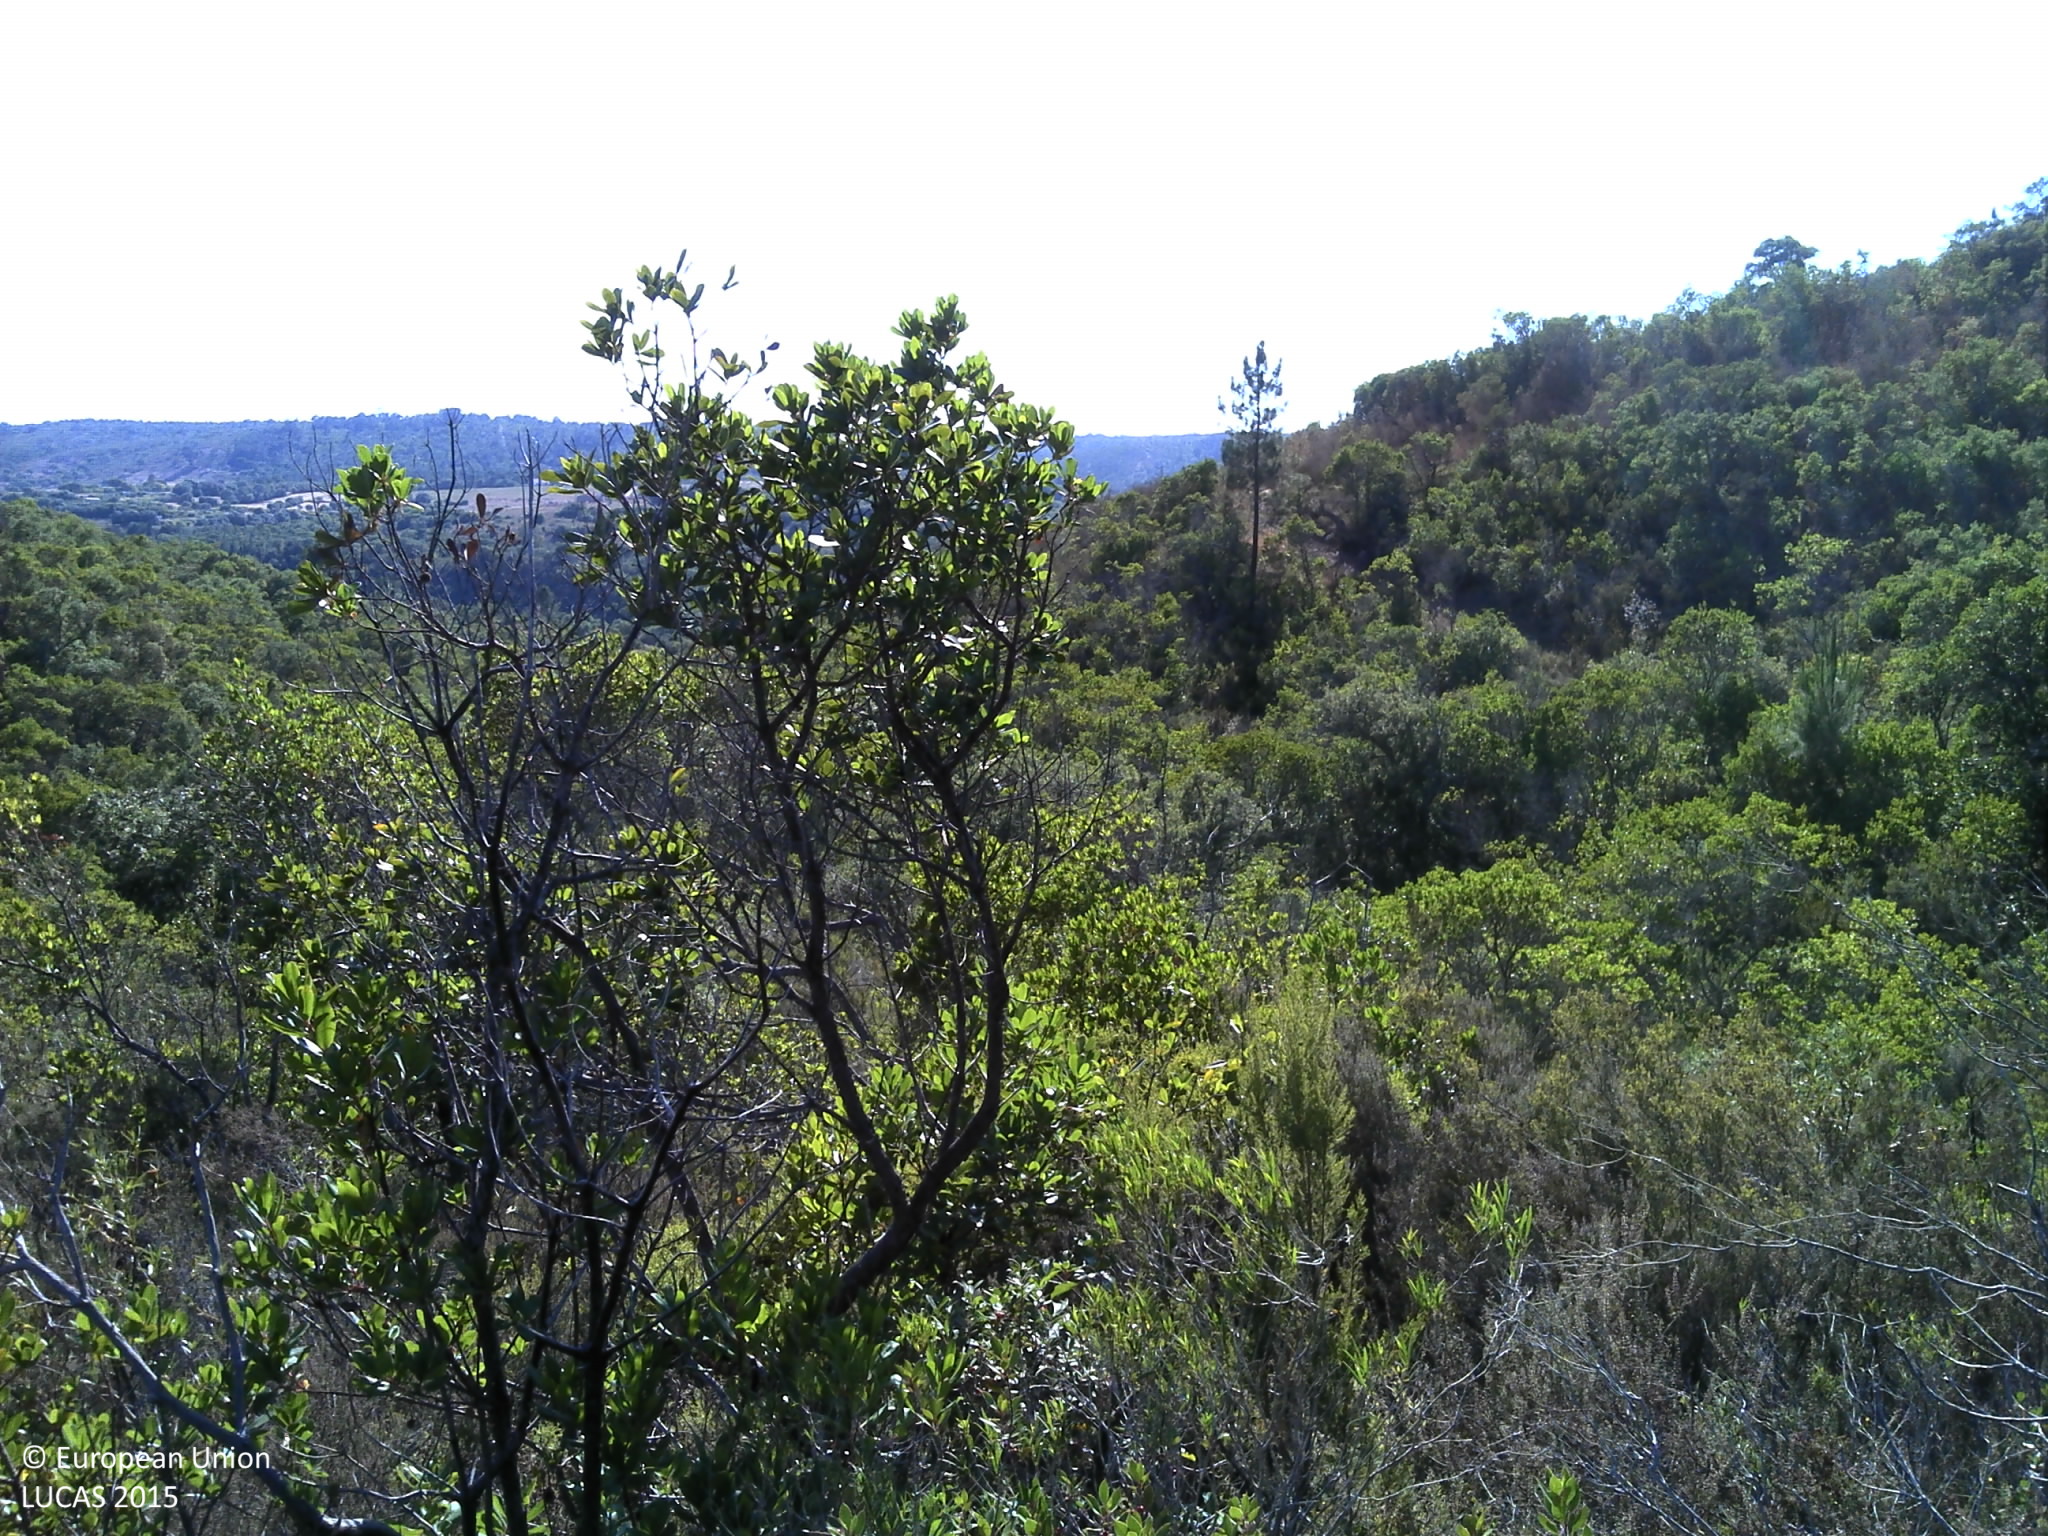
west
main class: Shrubland
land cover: Shrubland with sparse tree cover
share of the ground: > 75 %
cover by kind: shrubs 80 %, herbaceous plants 10 %, broadleaved forest trees 5 %, unconsolidated bare surface 5 %
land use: Forestry
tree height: < 5 m
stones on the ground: < 10 %
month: June
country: PT
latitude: 37.2840
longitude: -8.7923
